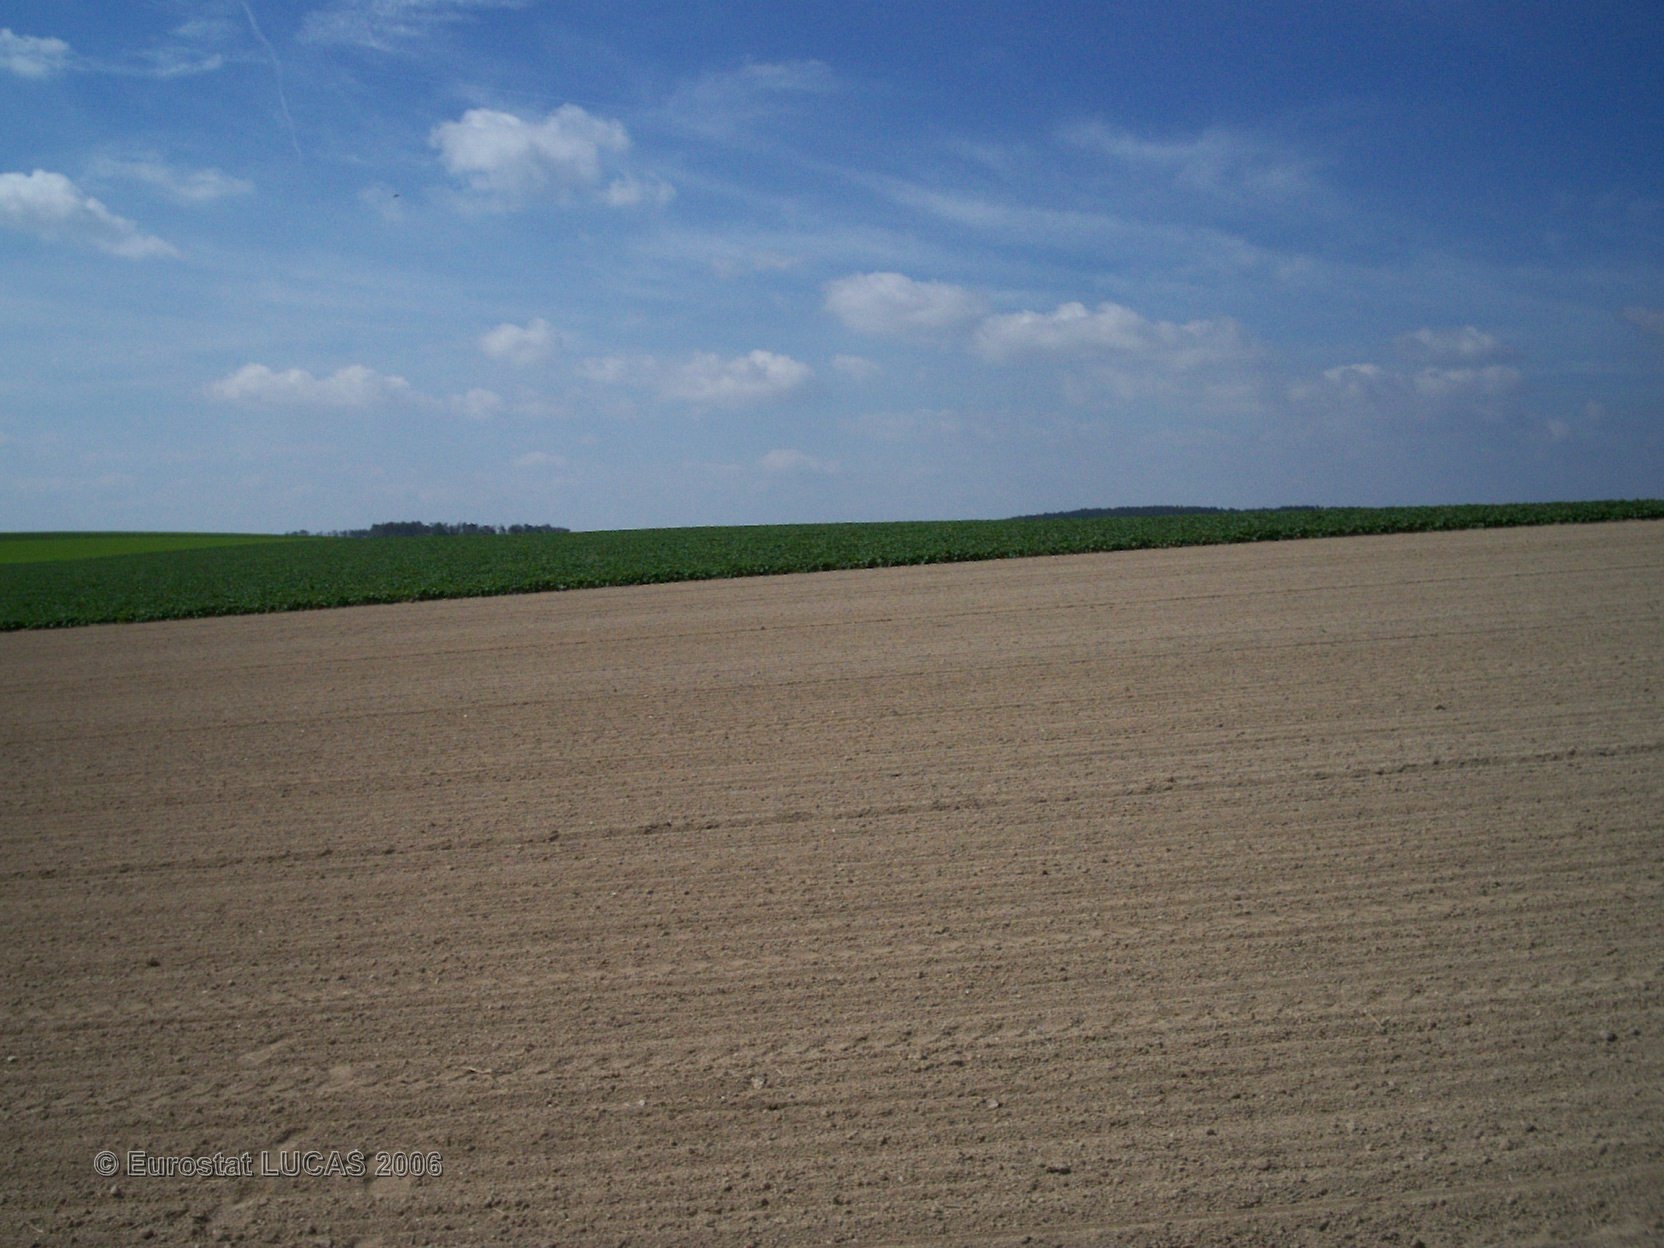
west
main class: Cropland
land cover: Sugar beet
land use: Agriculture (excluding fallow land and kitchen gardens)
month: June
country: FR
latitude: 49.2343
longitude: 4.3791
